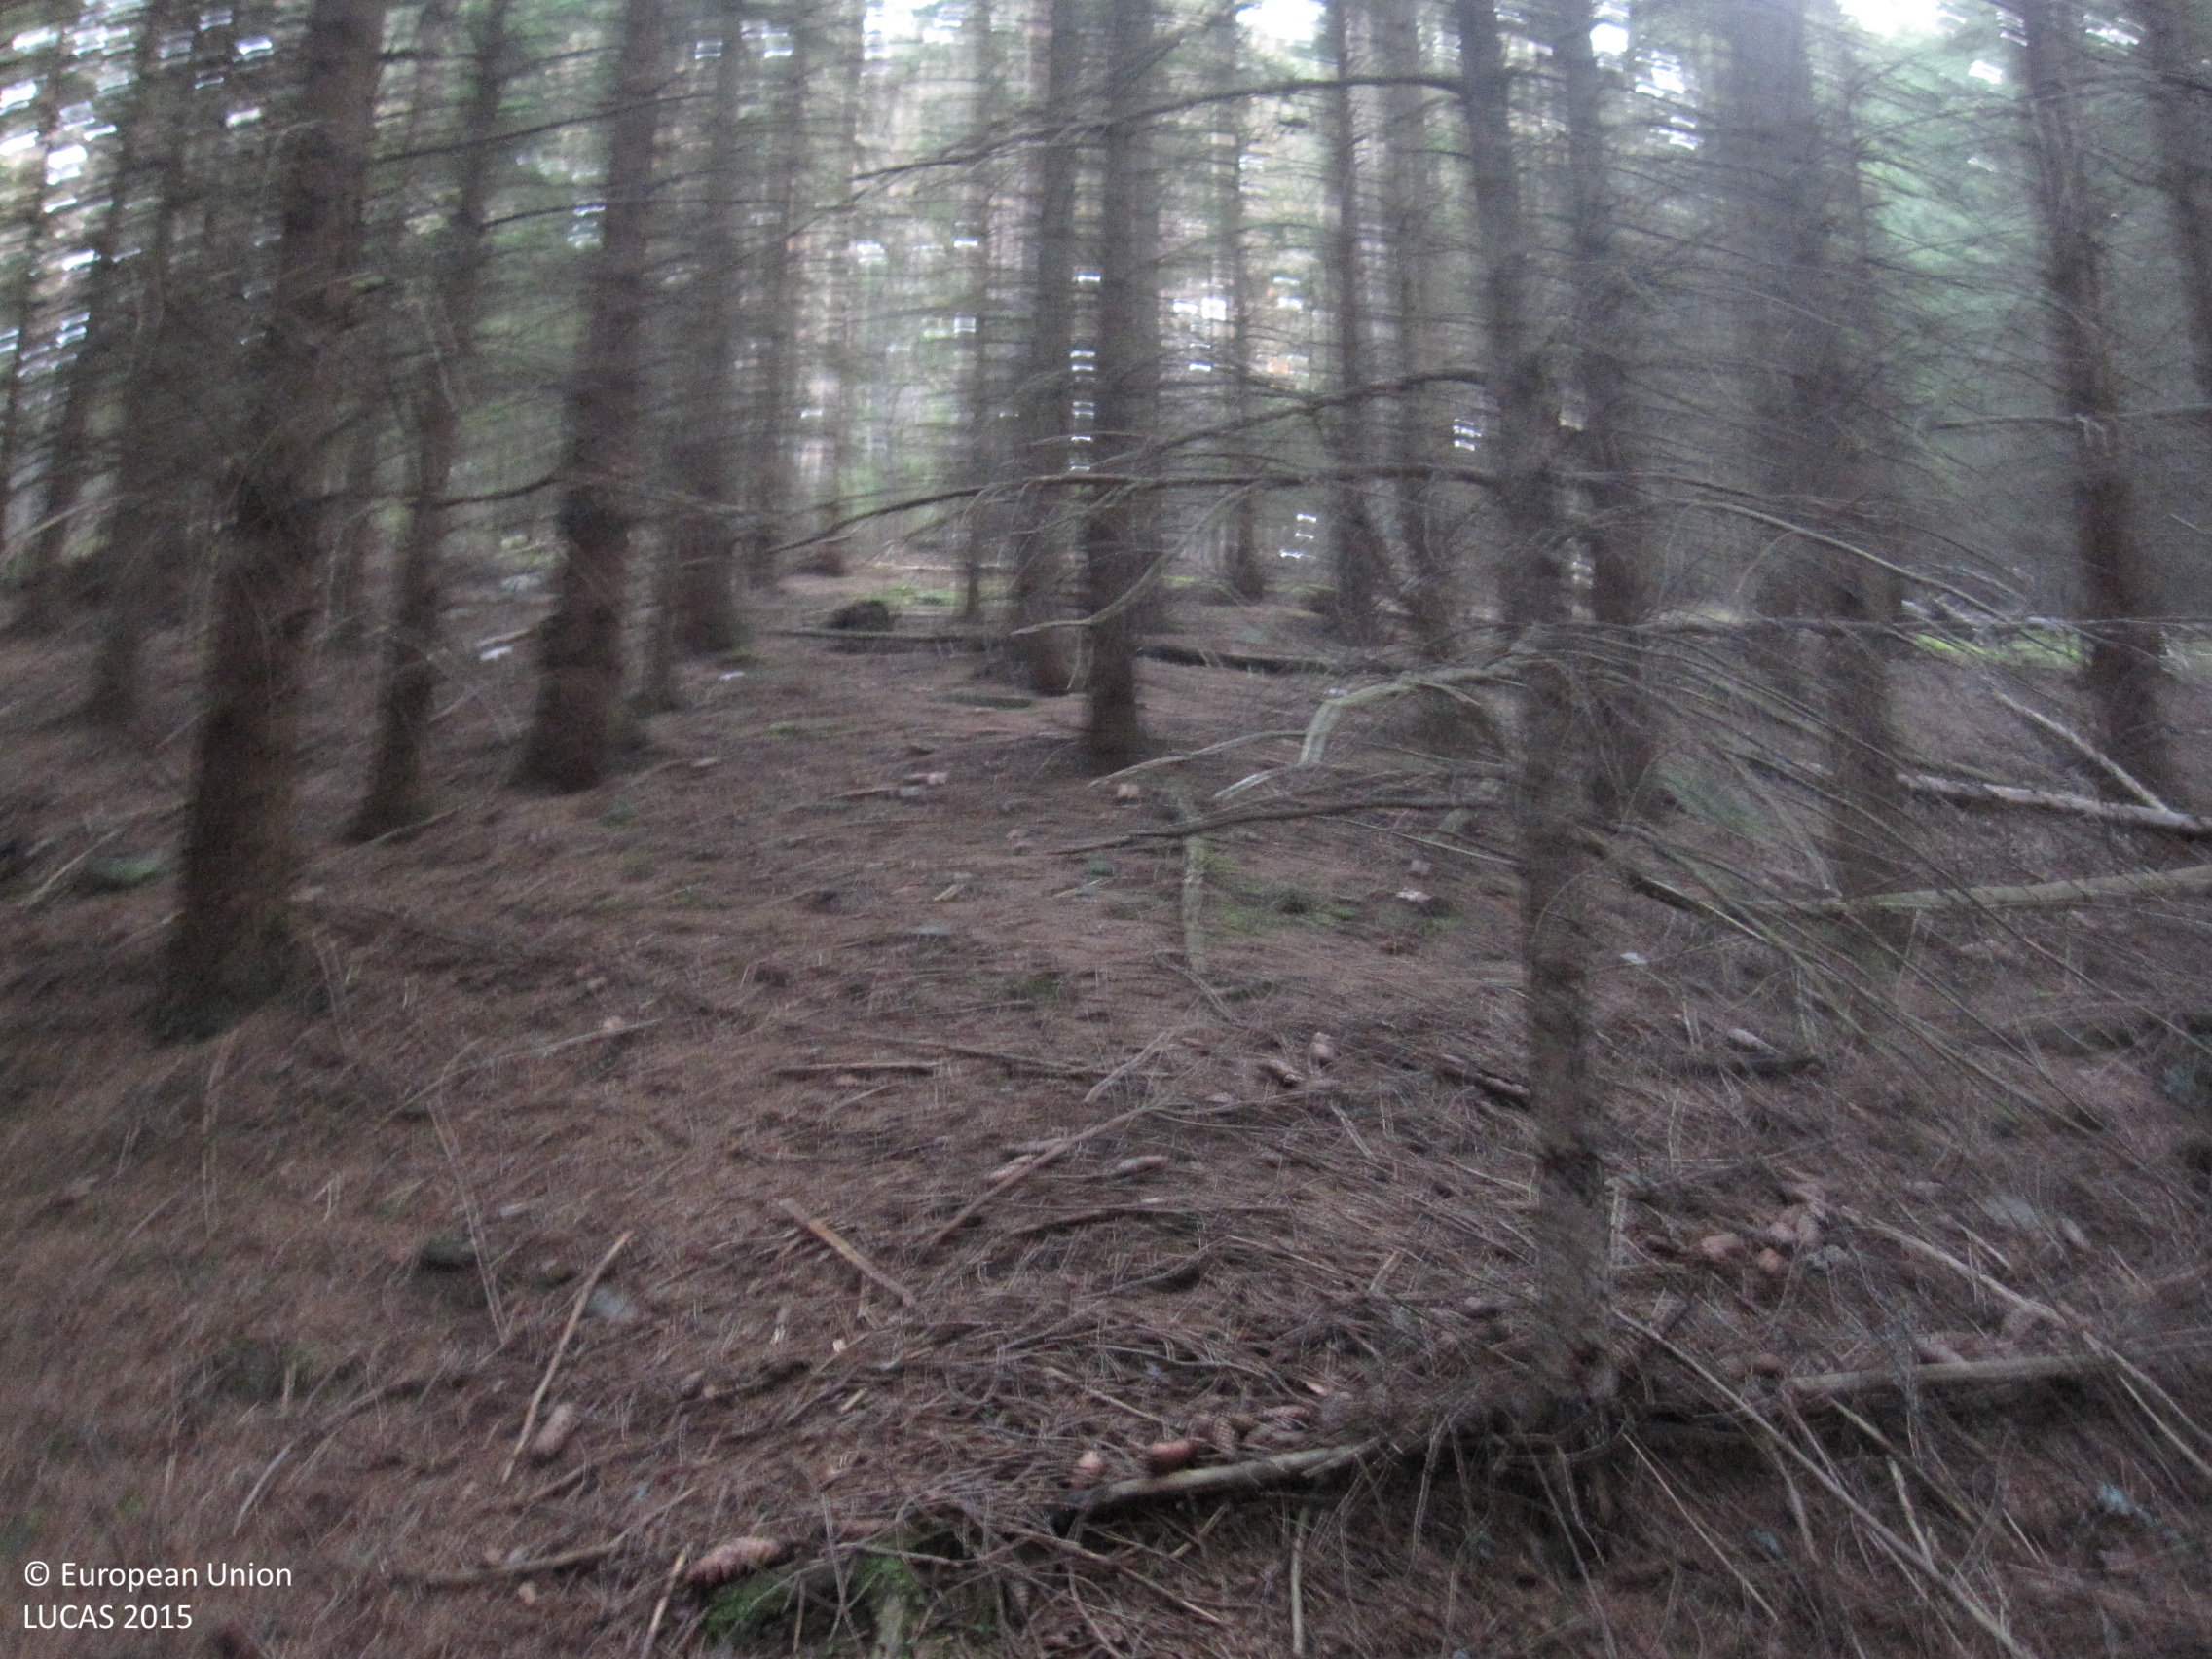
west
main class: Woodland
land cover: Spruce dominated coniferous woodland
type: hemiboreal forest and nemoral coniferous forest and mixed broadleaved-coniferous forest
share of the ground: > 75 %
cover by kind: coniferous forest trees 95 %, unconsolidated bare surface 5 %
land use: Forestry
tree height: > 5 m
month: August
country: DE
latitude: 50.5347
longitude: 11.4528
